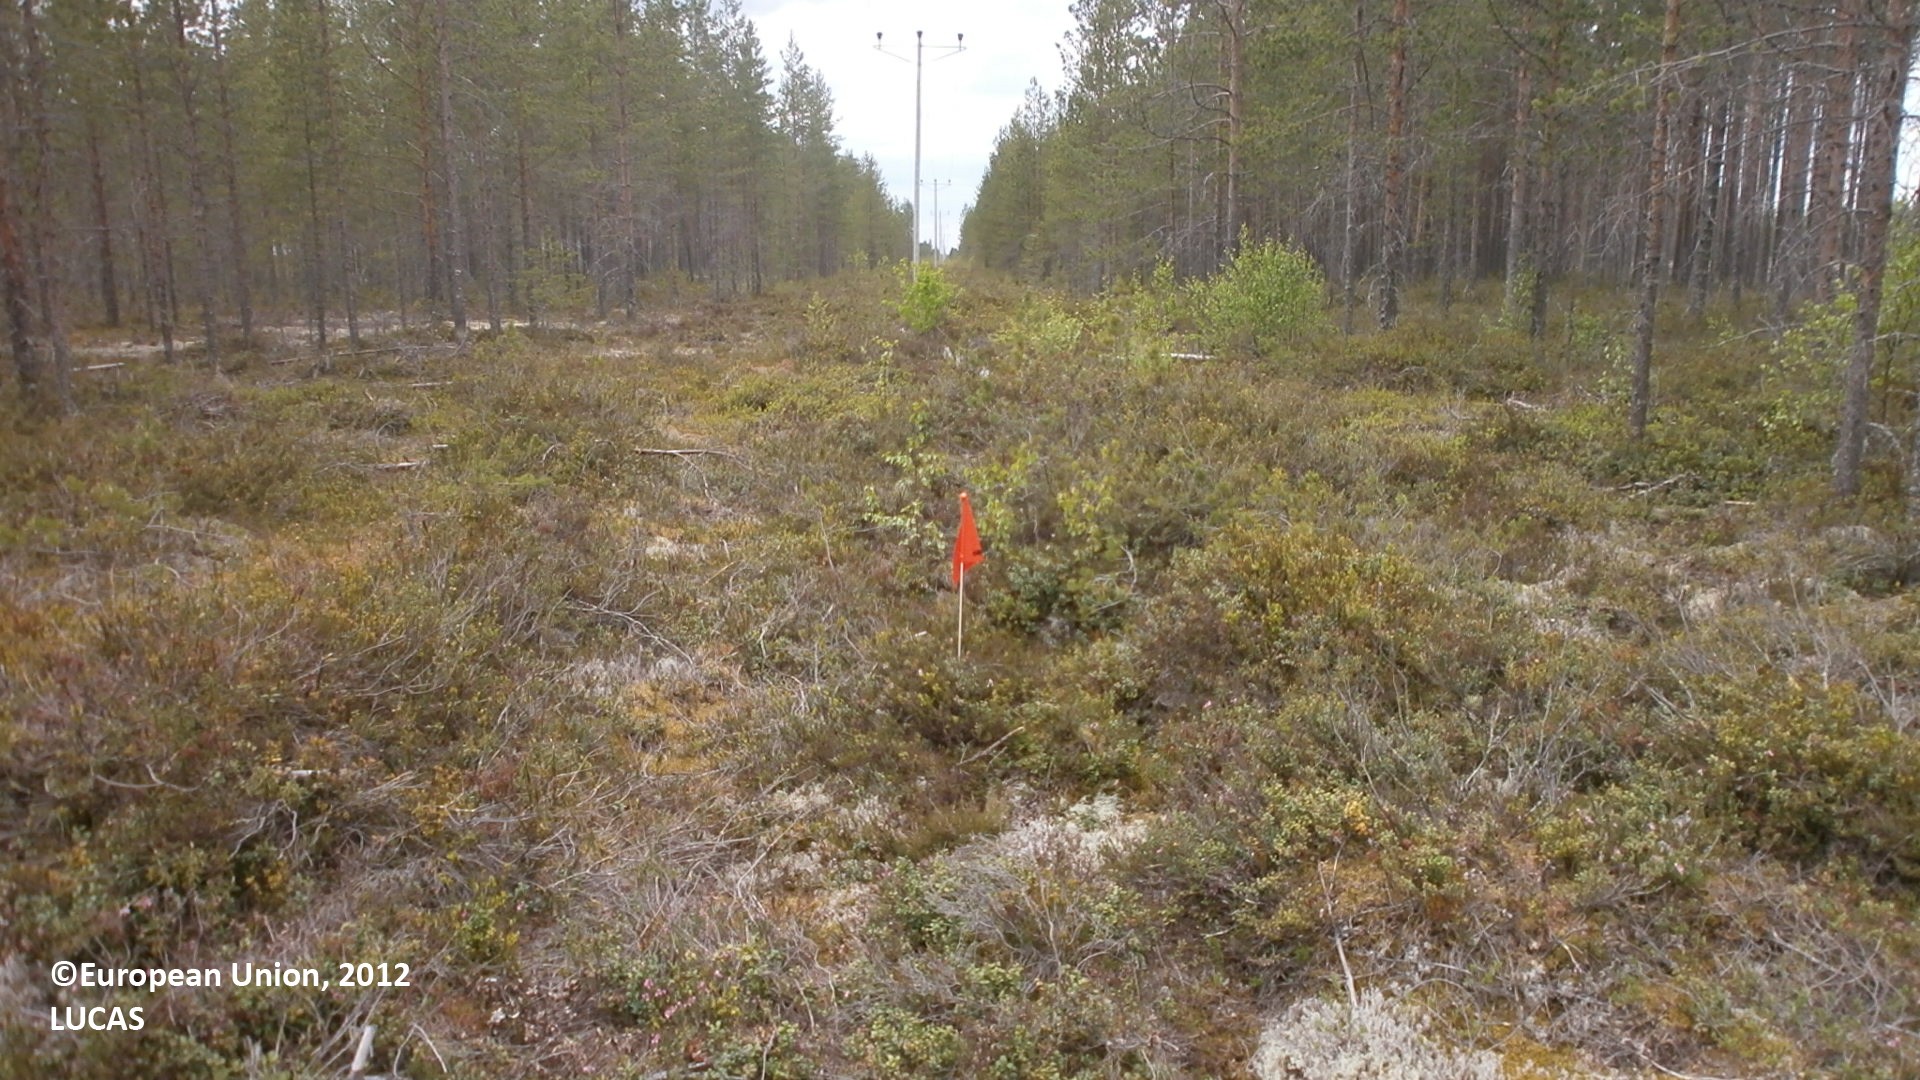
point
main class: Grassland
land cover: Spontaneously vegetated surfaces
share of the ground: > 75 %
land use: Energy production
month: June
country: FI
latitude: 64.4487
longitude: 25.0631
